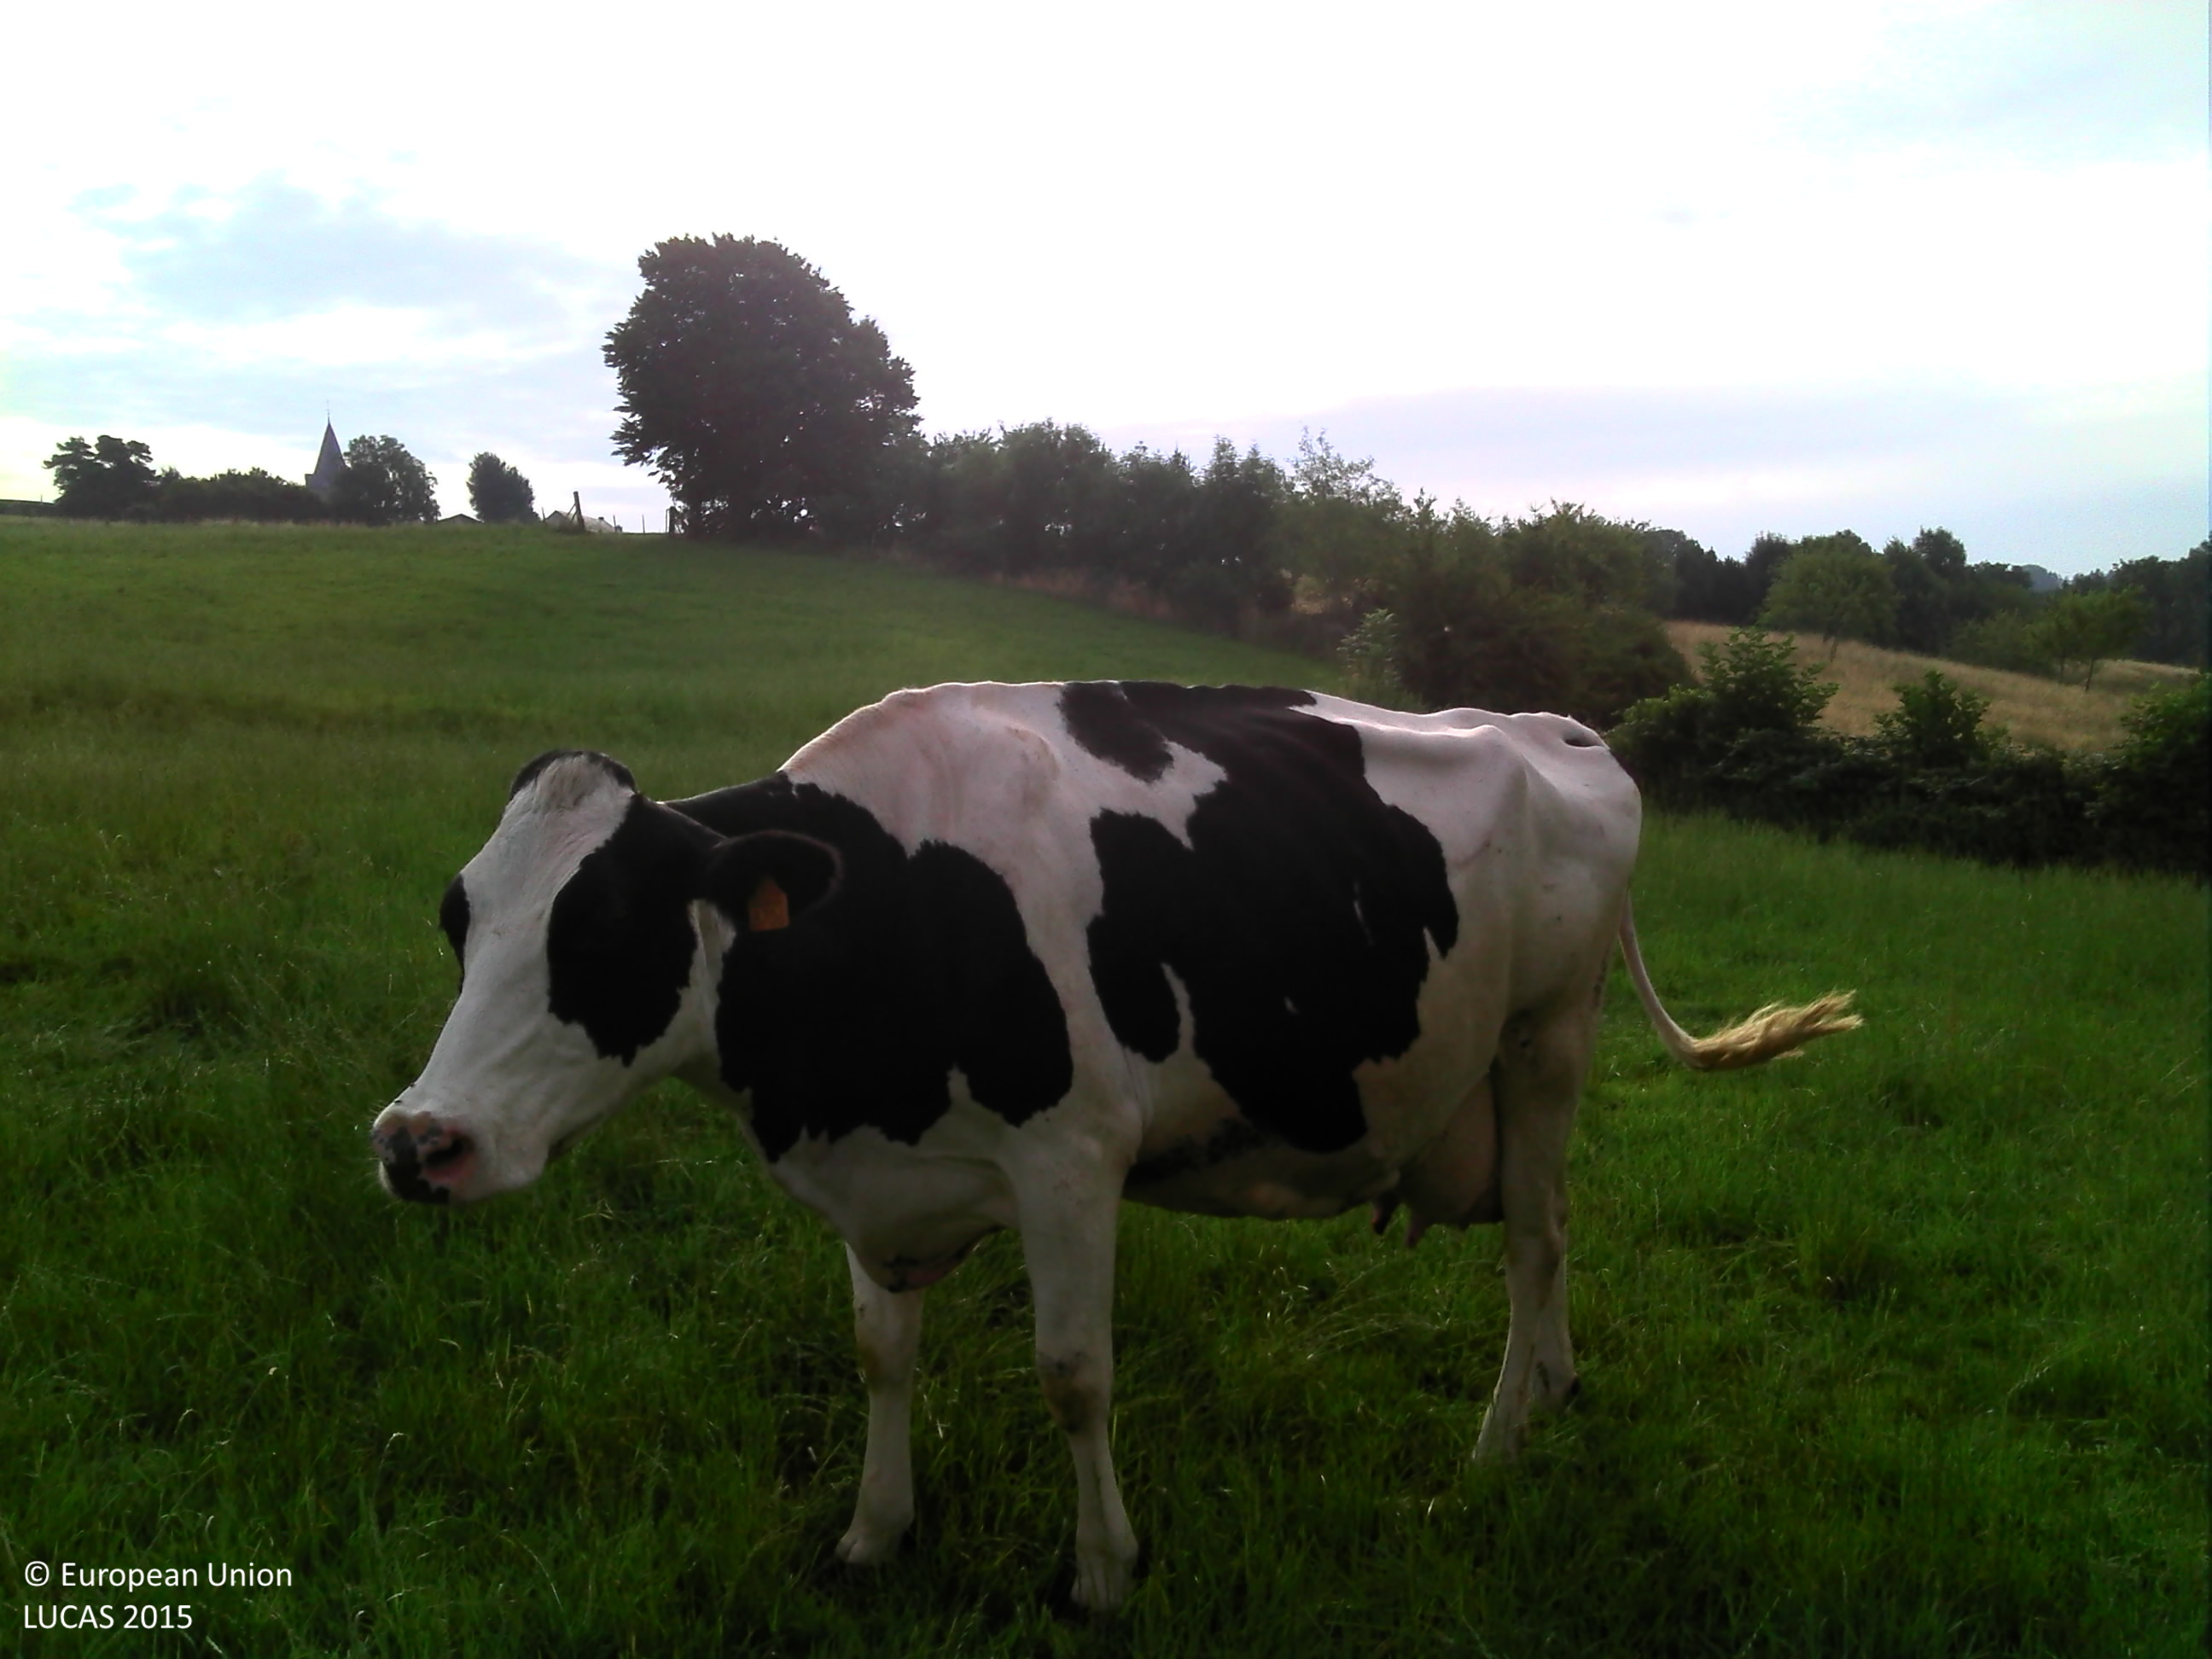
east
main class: Grassland
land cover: Grassland without tree/shrub cover
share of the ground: > 75 %
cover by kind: herbaceous plants 100 %
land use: Agriculture (excluding fallow land and kitchen gardens)
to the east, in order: Grassland without tree/shrub cover; Fences; Abandoned hedges; Grassland without tree/shrub cover; Fences; Abandoned hedges; Fences; Grassland with sparse tree/shrub cover; Fences; Grassland without tree/shrub cover; Artificial constructions in urban areas
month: July
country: BE
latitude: 50.6808
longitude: 5.7387
